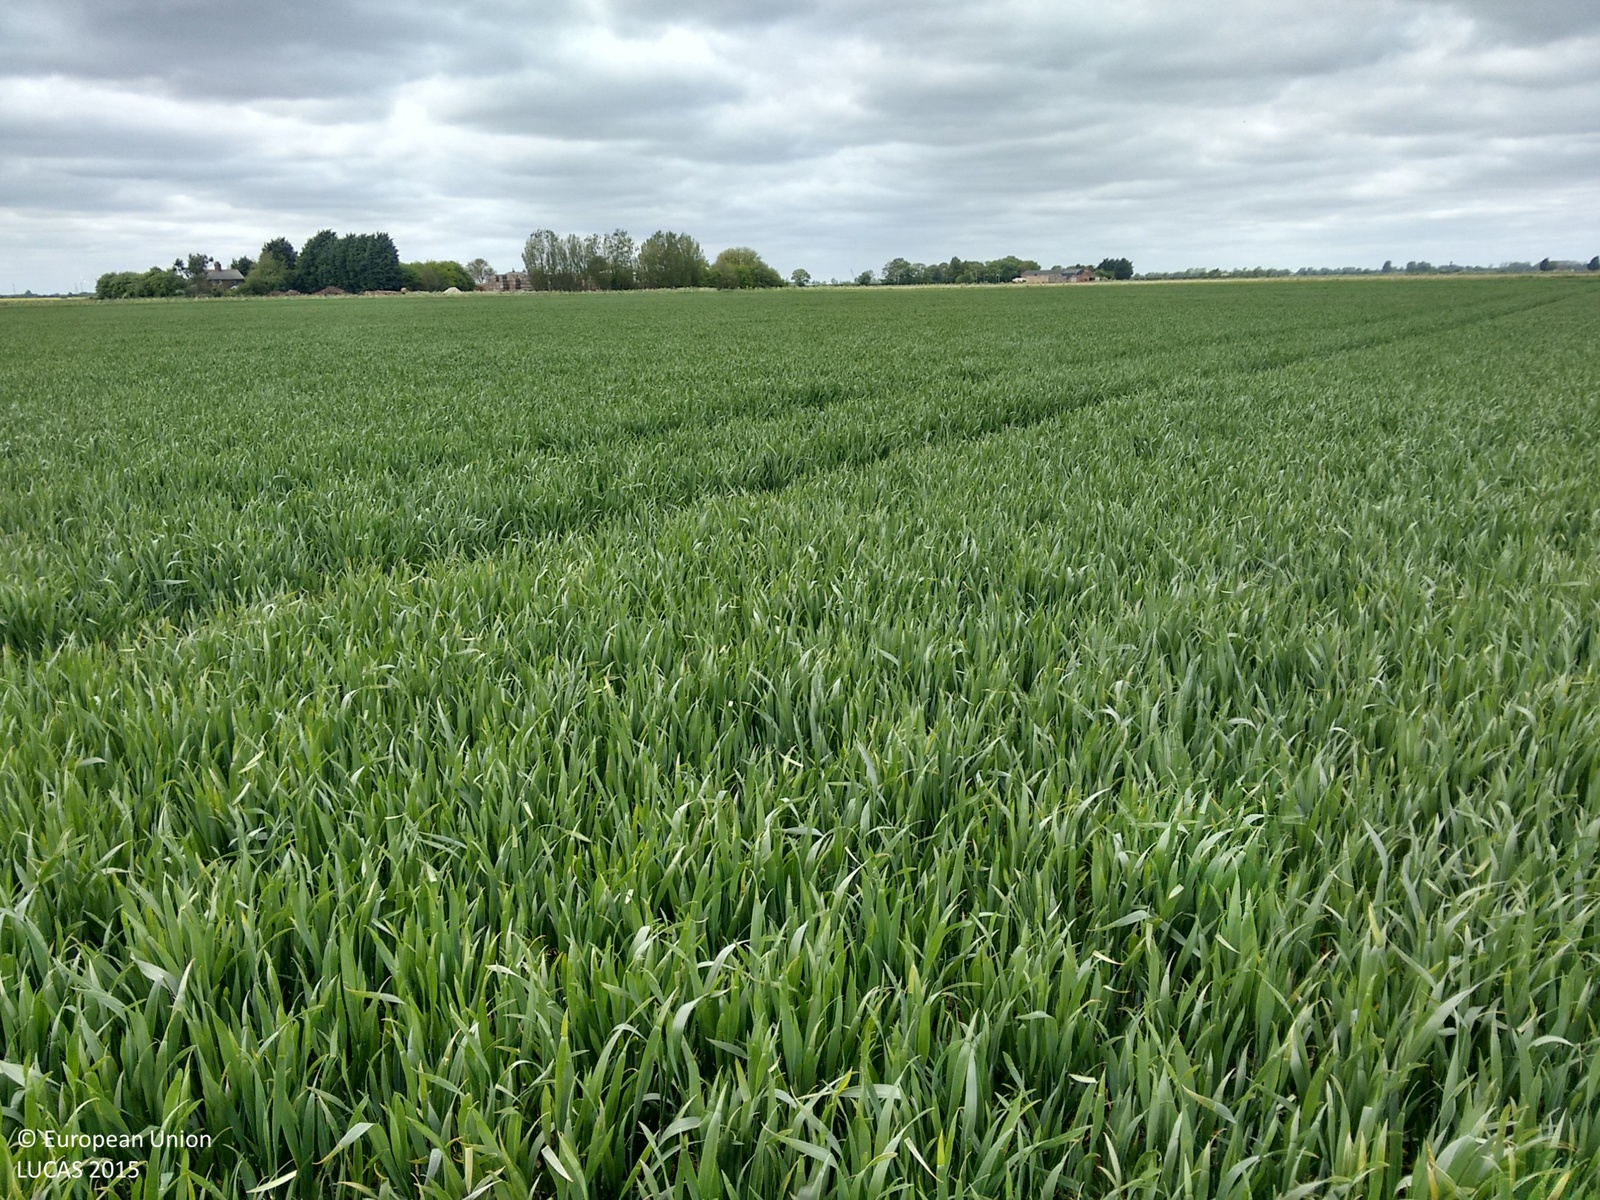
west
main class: Cropland
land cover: Barley
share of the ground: > 75 %
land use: Agriculture (excluding fallow land and kitchen gardens)
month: May
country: GB
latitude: 52.7731
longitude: 0.2613
